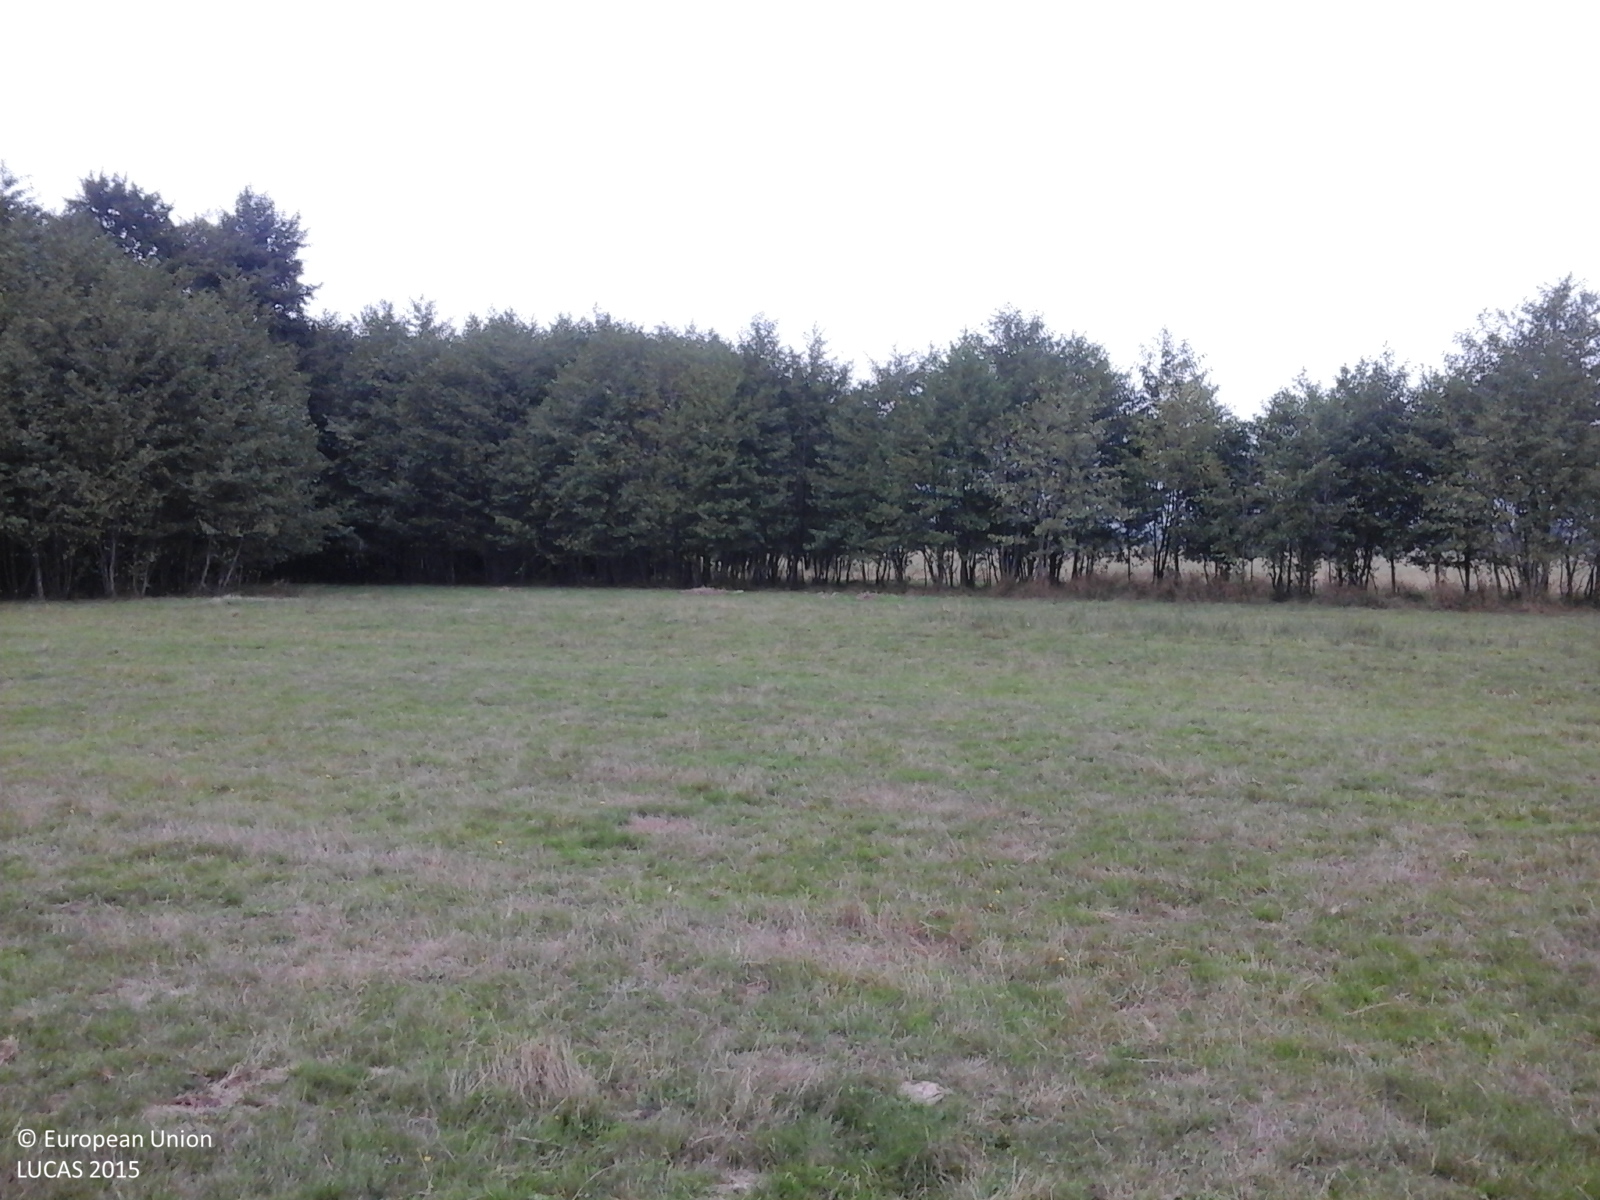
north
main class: Grassland
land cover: Grassland without tree/shrub cover
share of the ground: > 75 %
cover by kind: herbaceous plants 100 %
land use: Agriculture (excluding fallow land and kitchen gardens)
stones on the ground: < 10 %
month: September
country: RO
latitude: 45.1019
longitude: 23.2581
